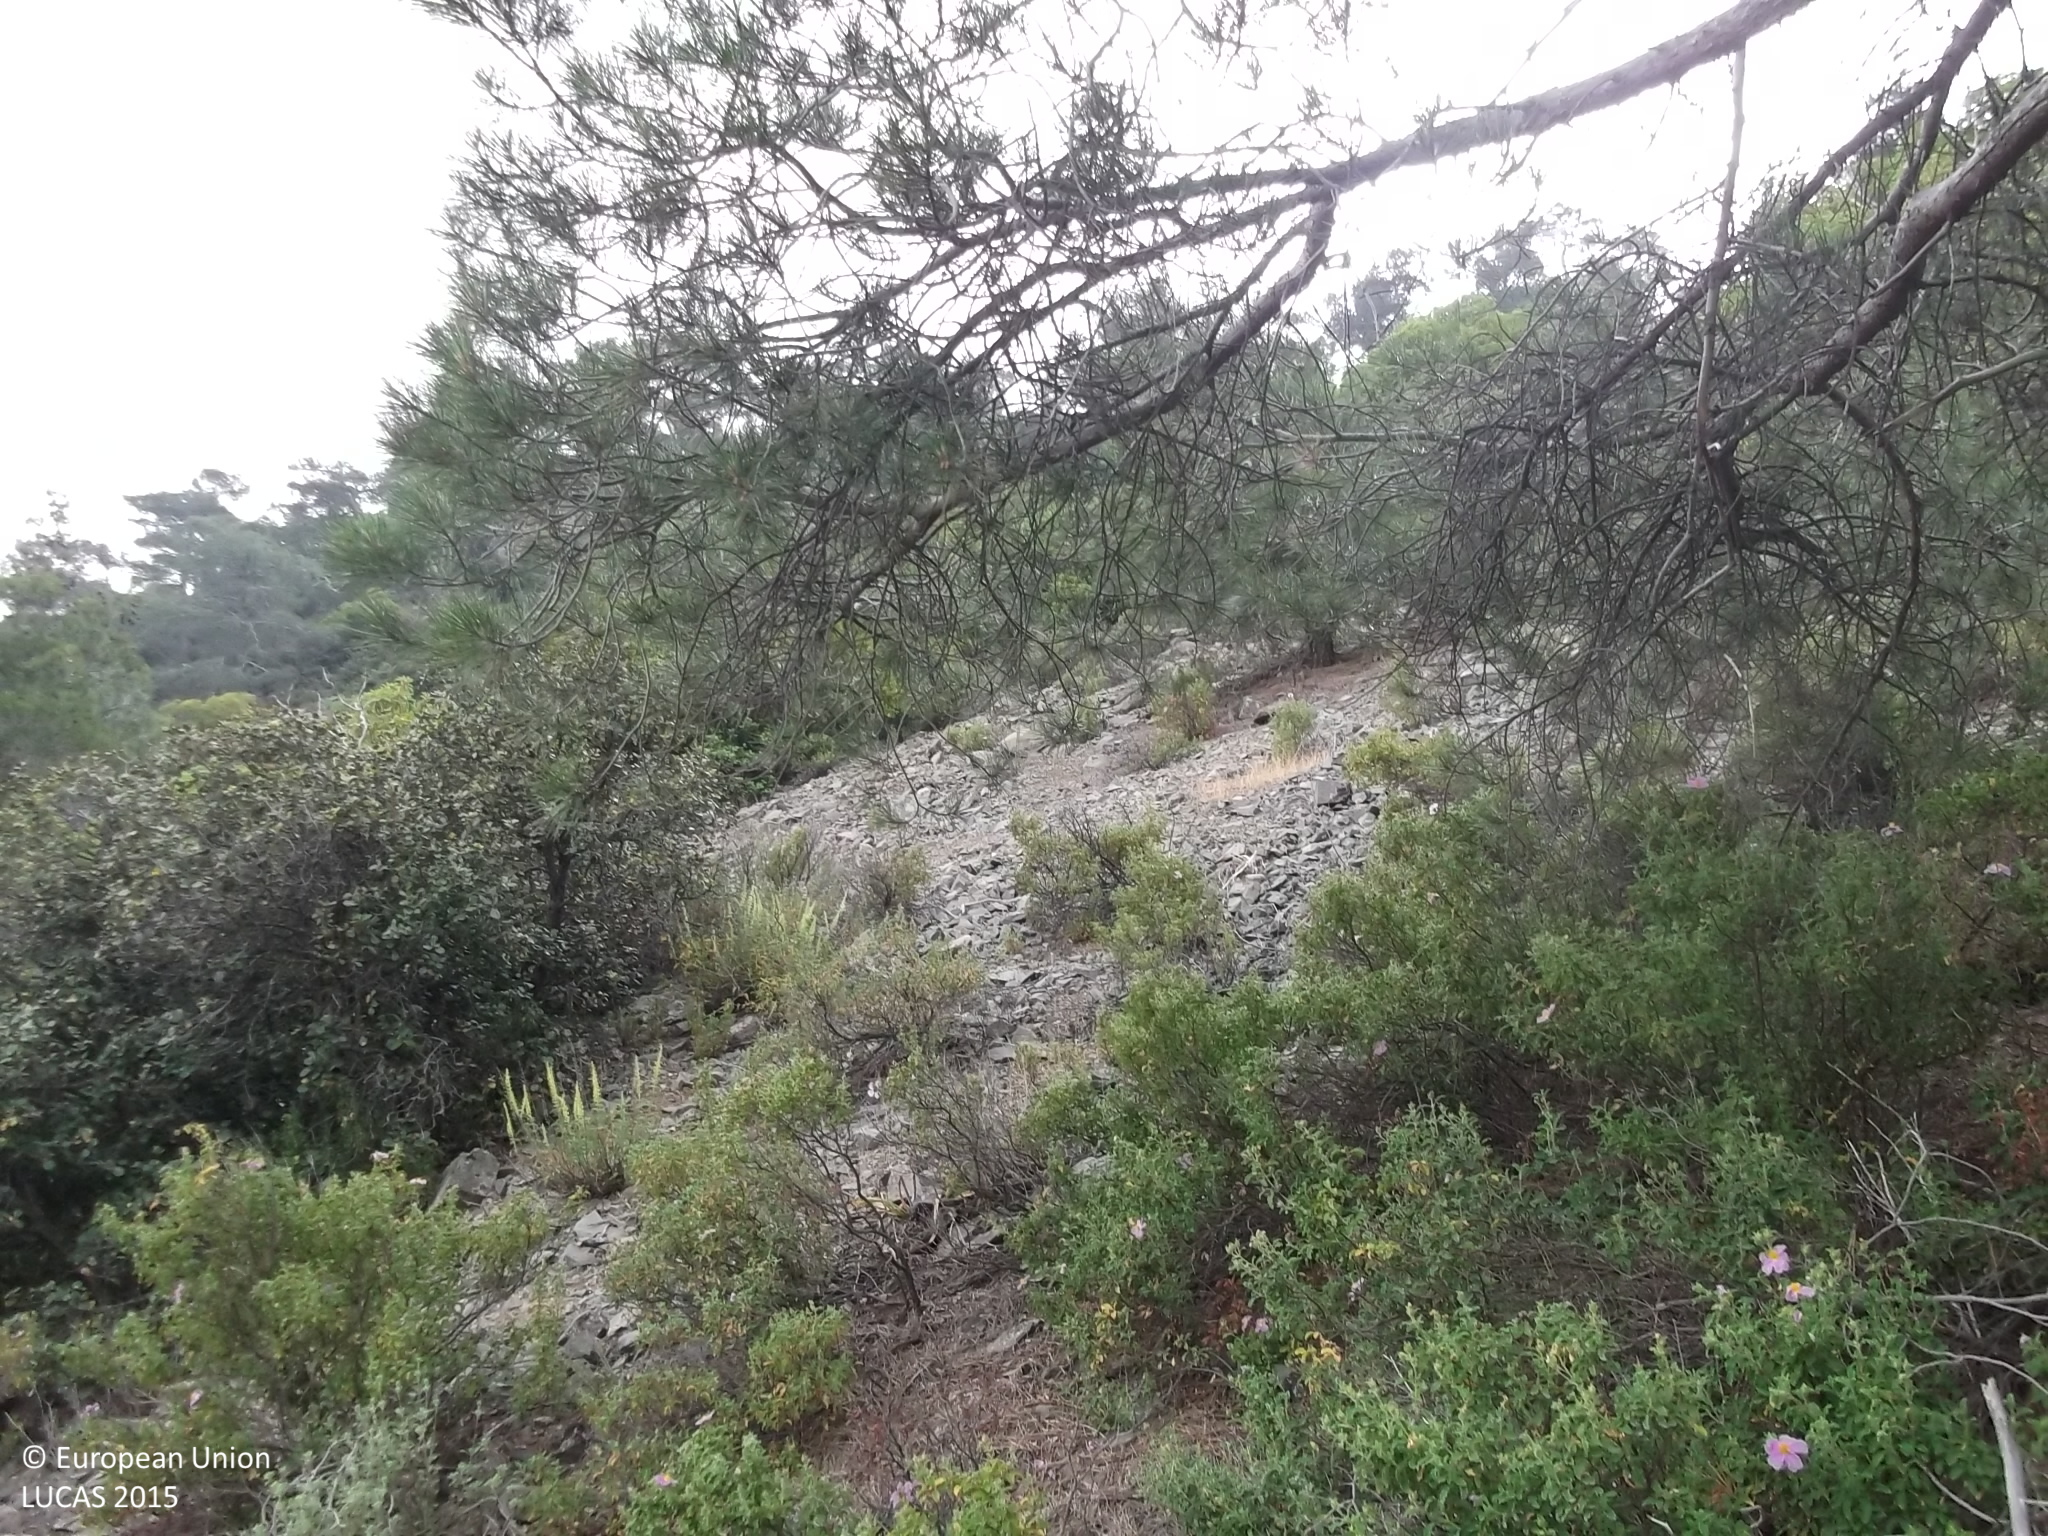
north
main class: Woodland
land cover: Pine dominated mixed woodland
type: coniferous forest of the mediterranean region
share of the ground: > 75 %
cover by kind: coniferous forest trees 60 %, broadleaved forest trees 20 %, shrubs 10 %, unconsolidated bare surface 10 %
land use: Forestry
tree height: > 5 m
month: June
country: CY
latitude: 34.9664
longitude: 32.9858
